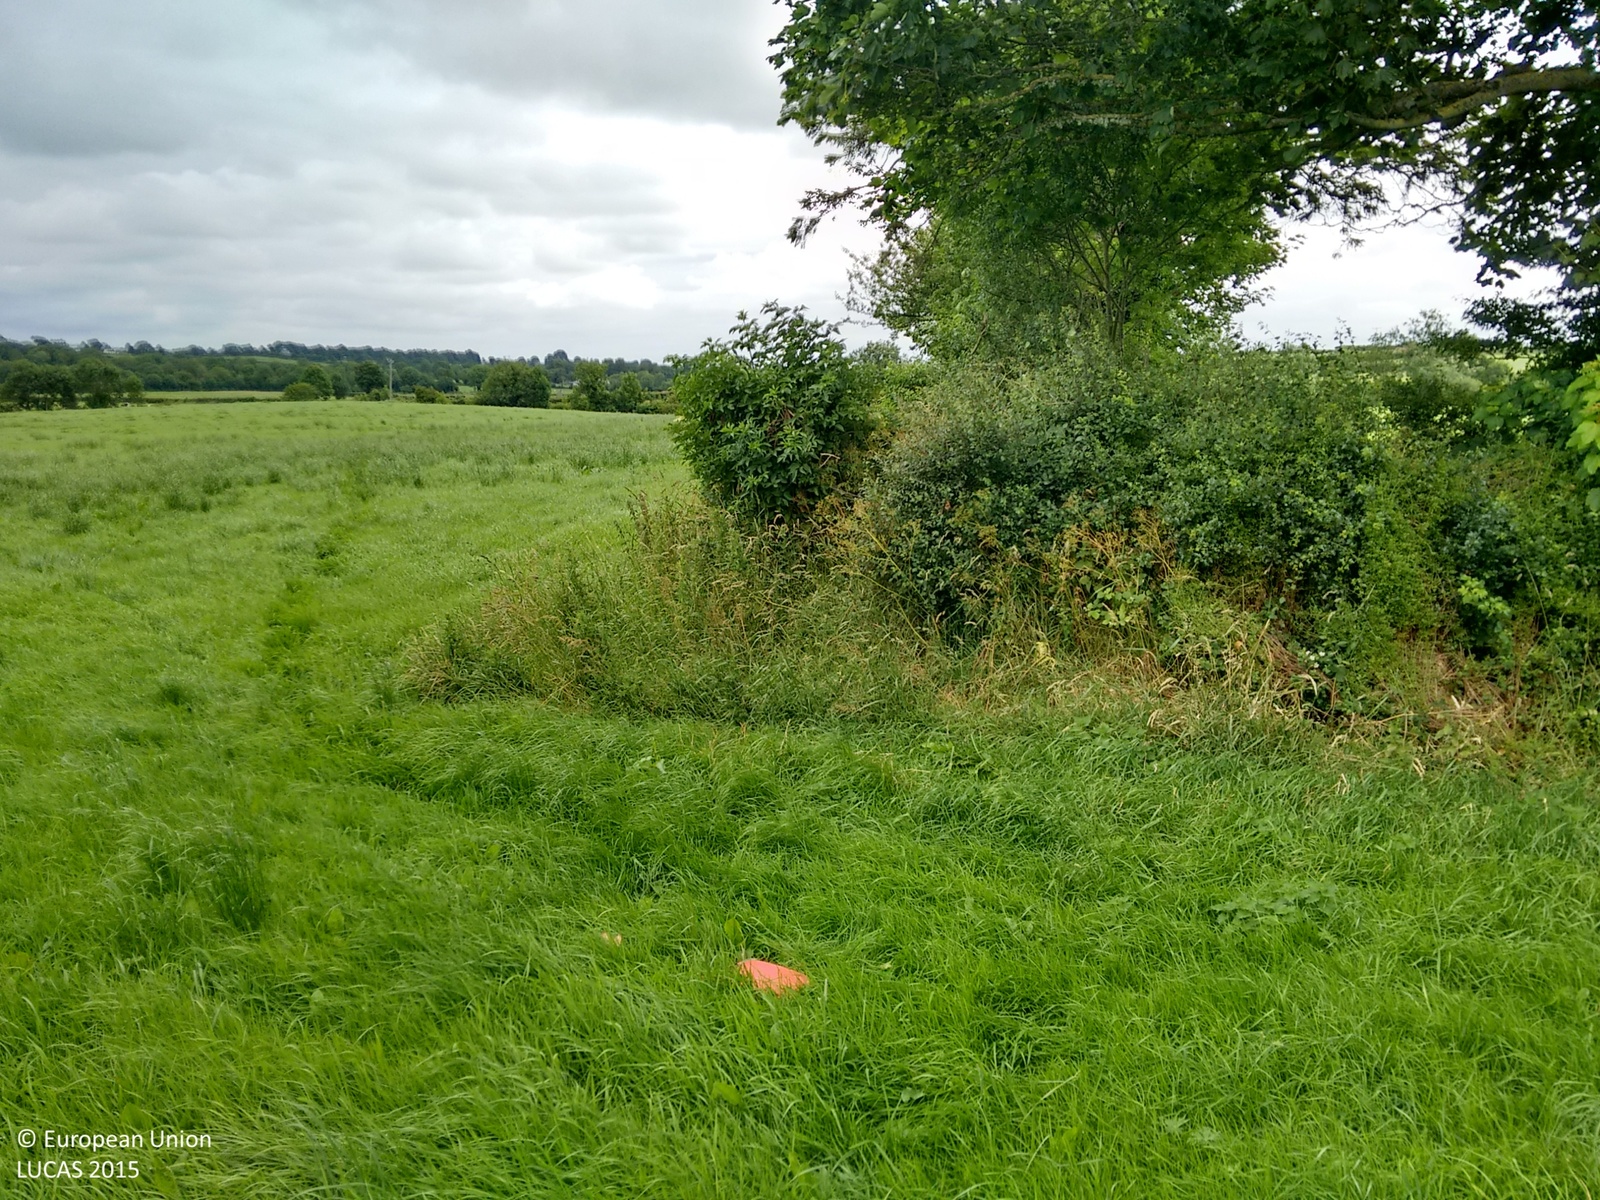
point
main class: Grassland
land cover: Grassland without tree/shrub cover
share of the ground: > 75 %
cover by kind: herbaceous plants 100 %
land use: Agriculture (excluding fallow land and kitchen gardens)
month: July
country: IE
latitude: 52.4470
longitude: -8.2068
